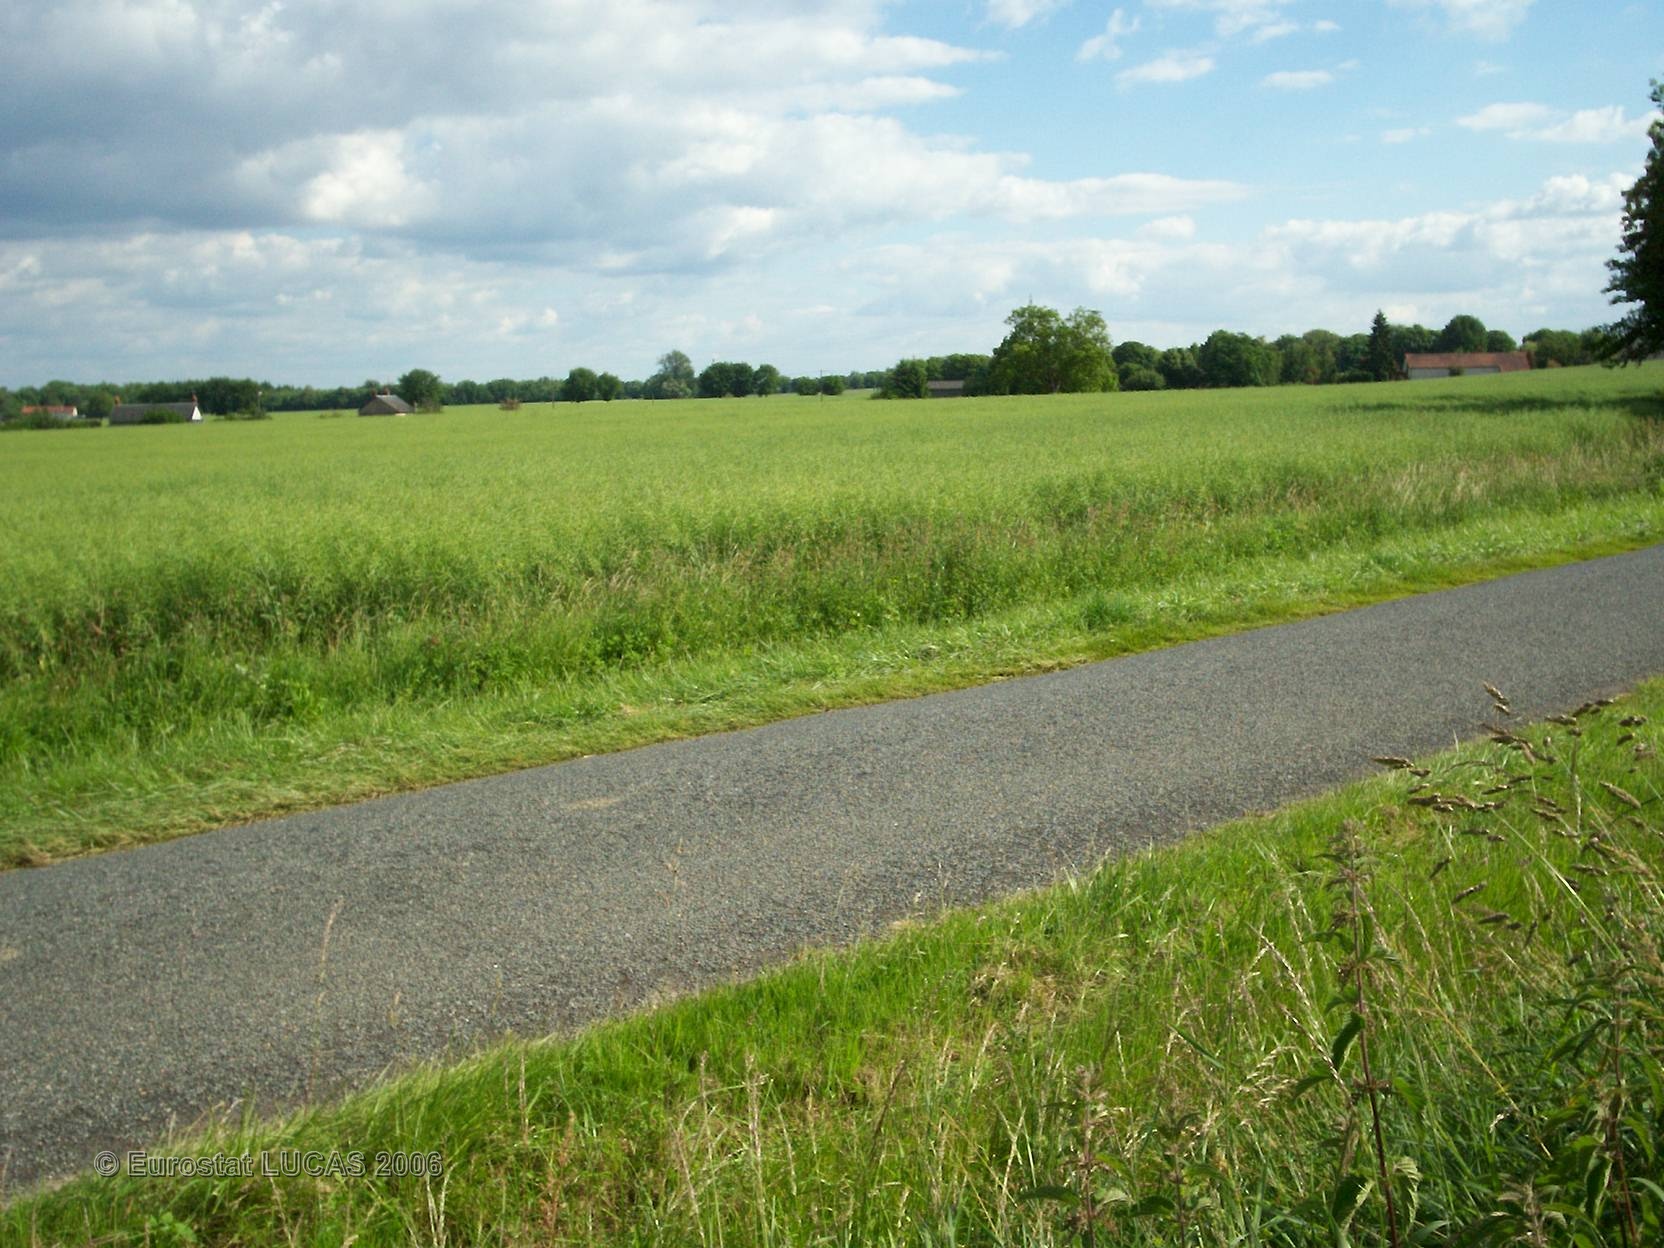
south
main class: Cropland
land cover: Rape and turnip rape
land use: Agriculture (excluding fallow land and kitchen gardens)
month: June
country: FR
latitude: 47.1156
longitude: 2.9970
